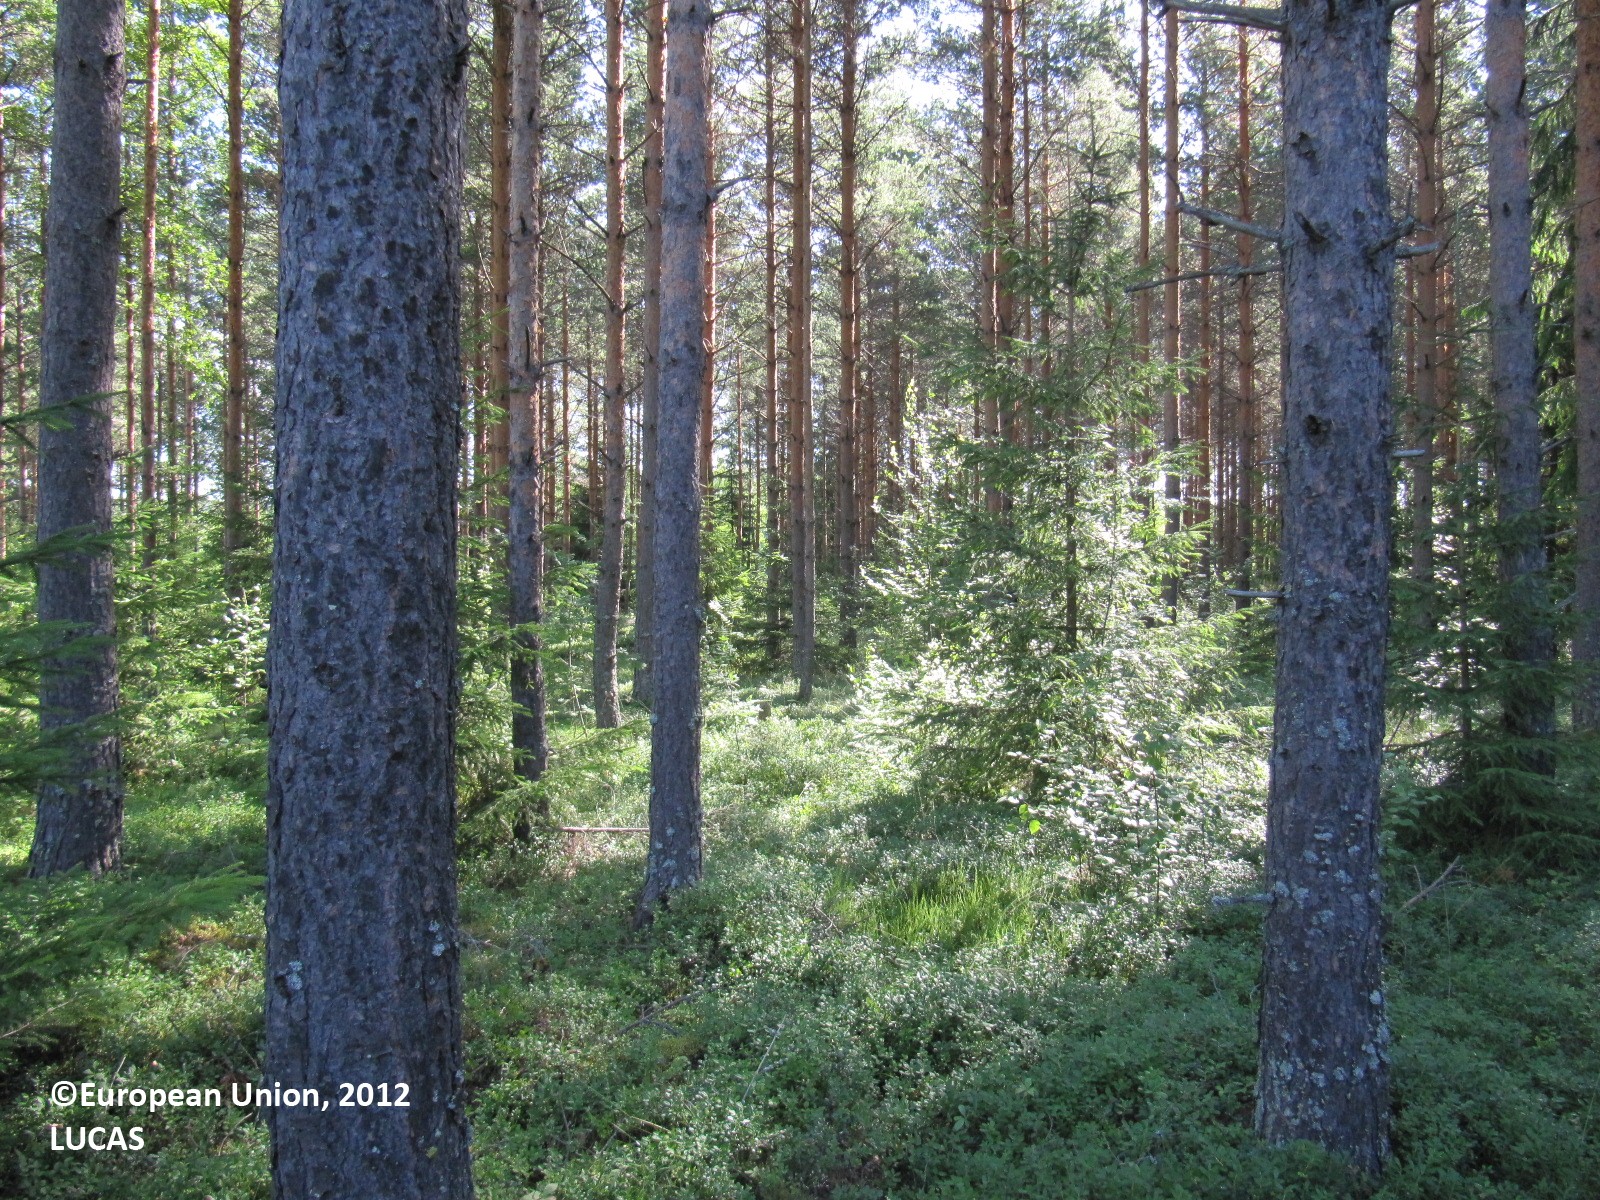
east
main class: Woodland
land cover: Pine dominated mixed woodland
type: boreal forest
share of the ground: > 75 %
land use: Forestry
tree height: > 5 m
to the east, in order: Pine dominated mixed woodland; Spontaneously vegetated surfaces; Sugar beet; Grass margins; Ditches and canals; Grass margins; Oats
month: July
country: FI
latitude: 60.9048
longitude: 24.5770
